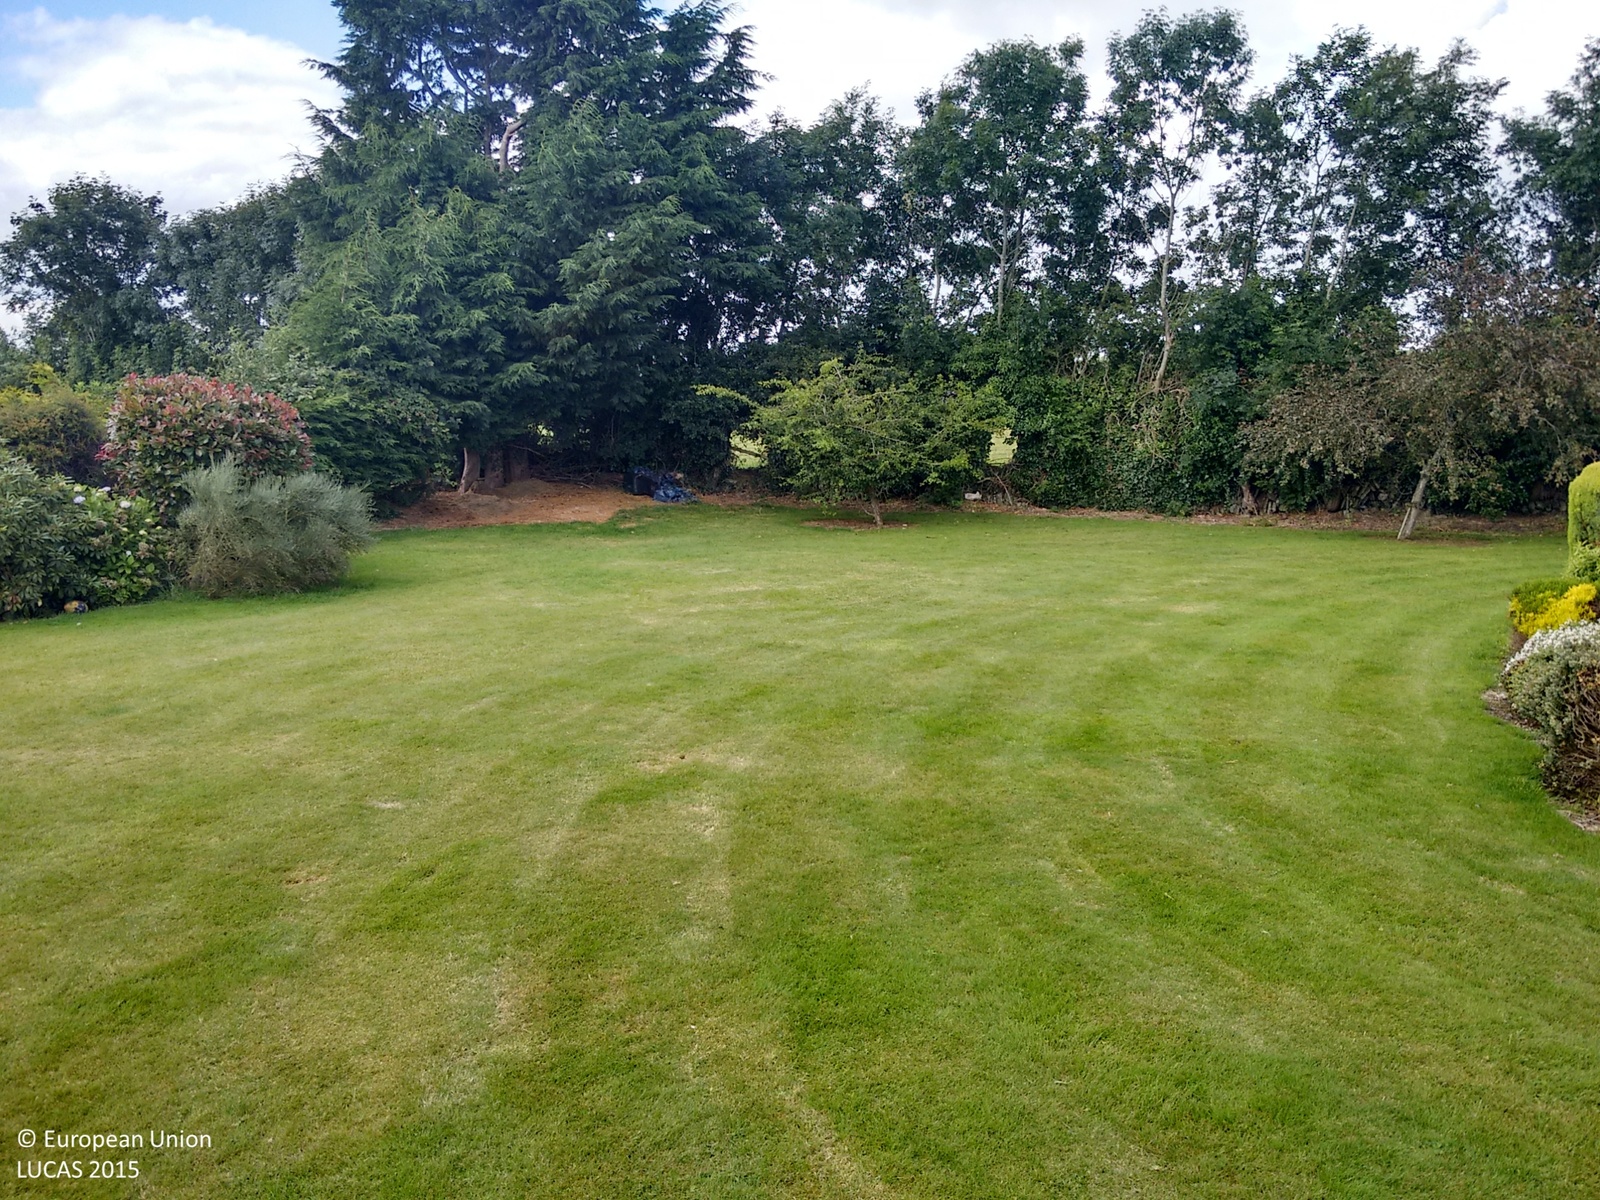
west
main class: Grassland
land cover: Grassland without tree/shrub cover
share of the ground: > 75 %
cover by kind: herbaceous plants 100 %
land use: Residential
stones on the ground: < 10 %
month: August
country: IE
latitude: 53.9569
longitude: -6.4461
